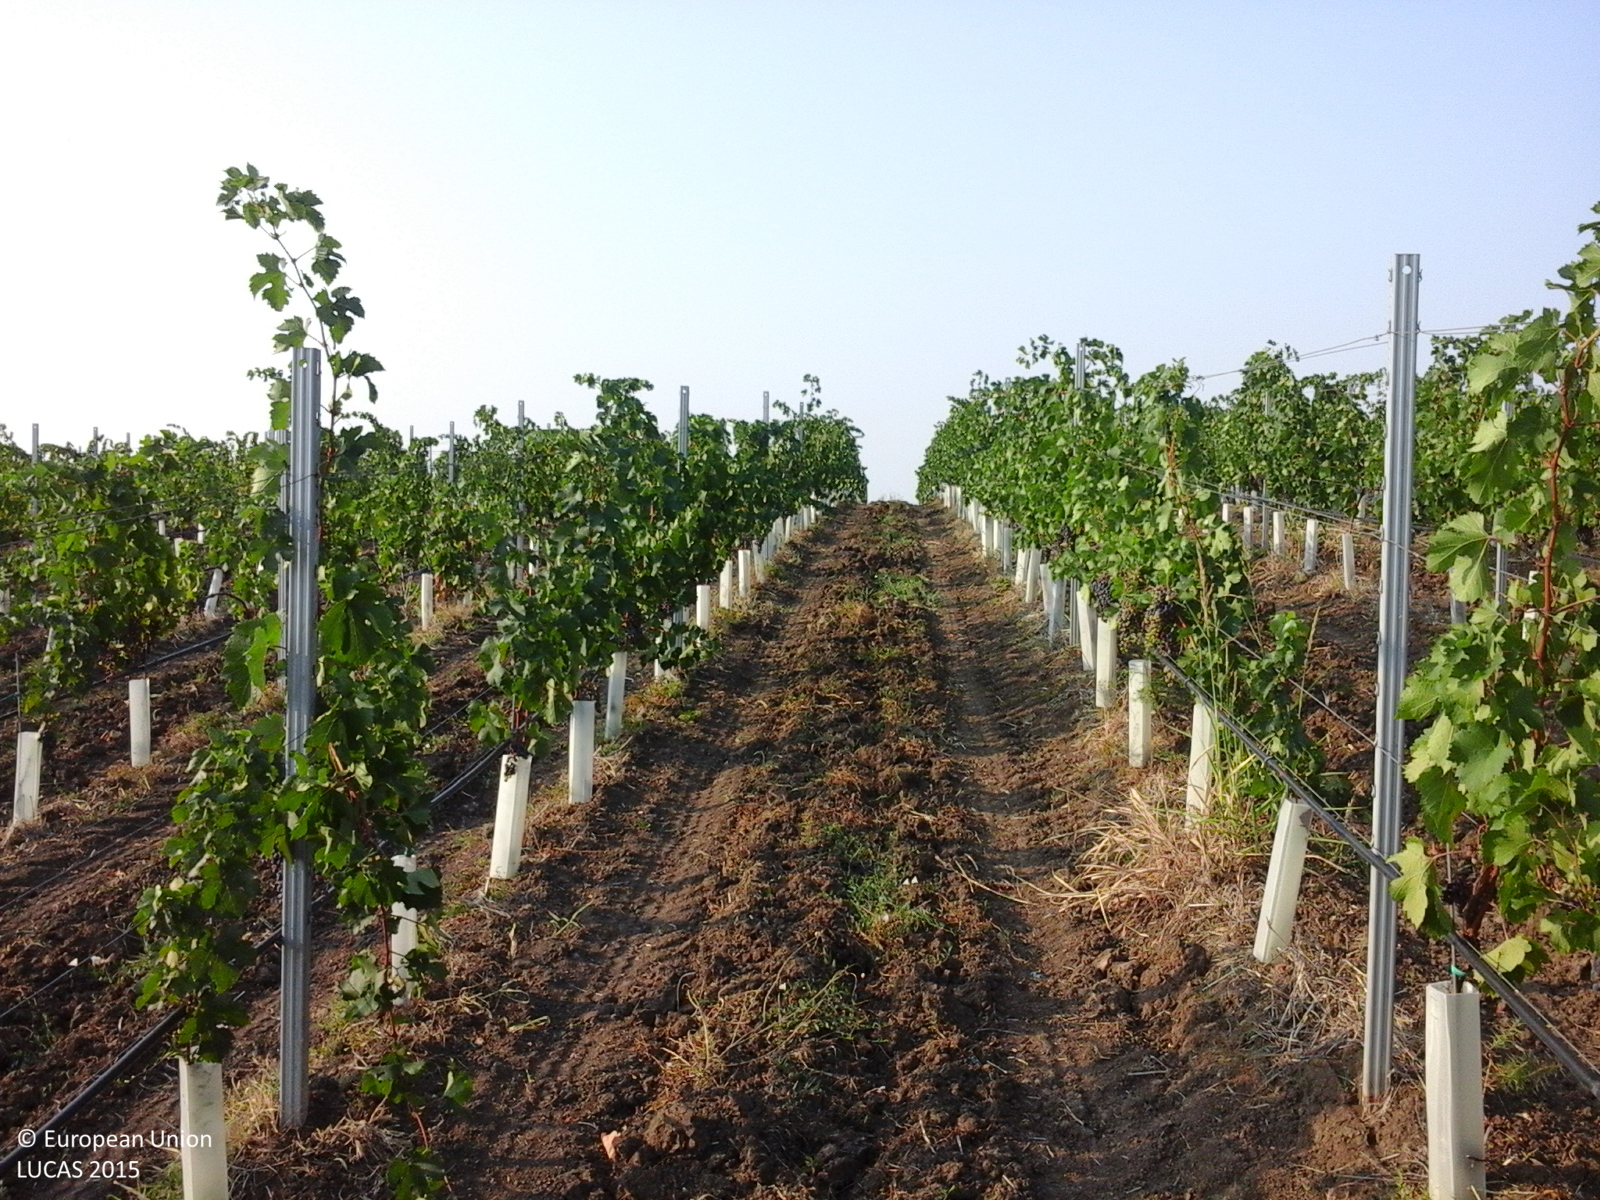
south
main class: Cropland
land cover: Vineyards
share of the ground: 25 - 50 %
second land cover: Other bare soil
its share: > 75 %
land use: Agriculture (excluding fallow land and kitchen gardens)
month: August
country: RO
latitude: 44.4921
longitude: 23.3172
